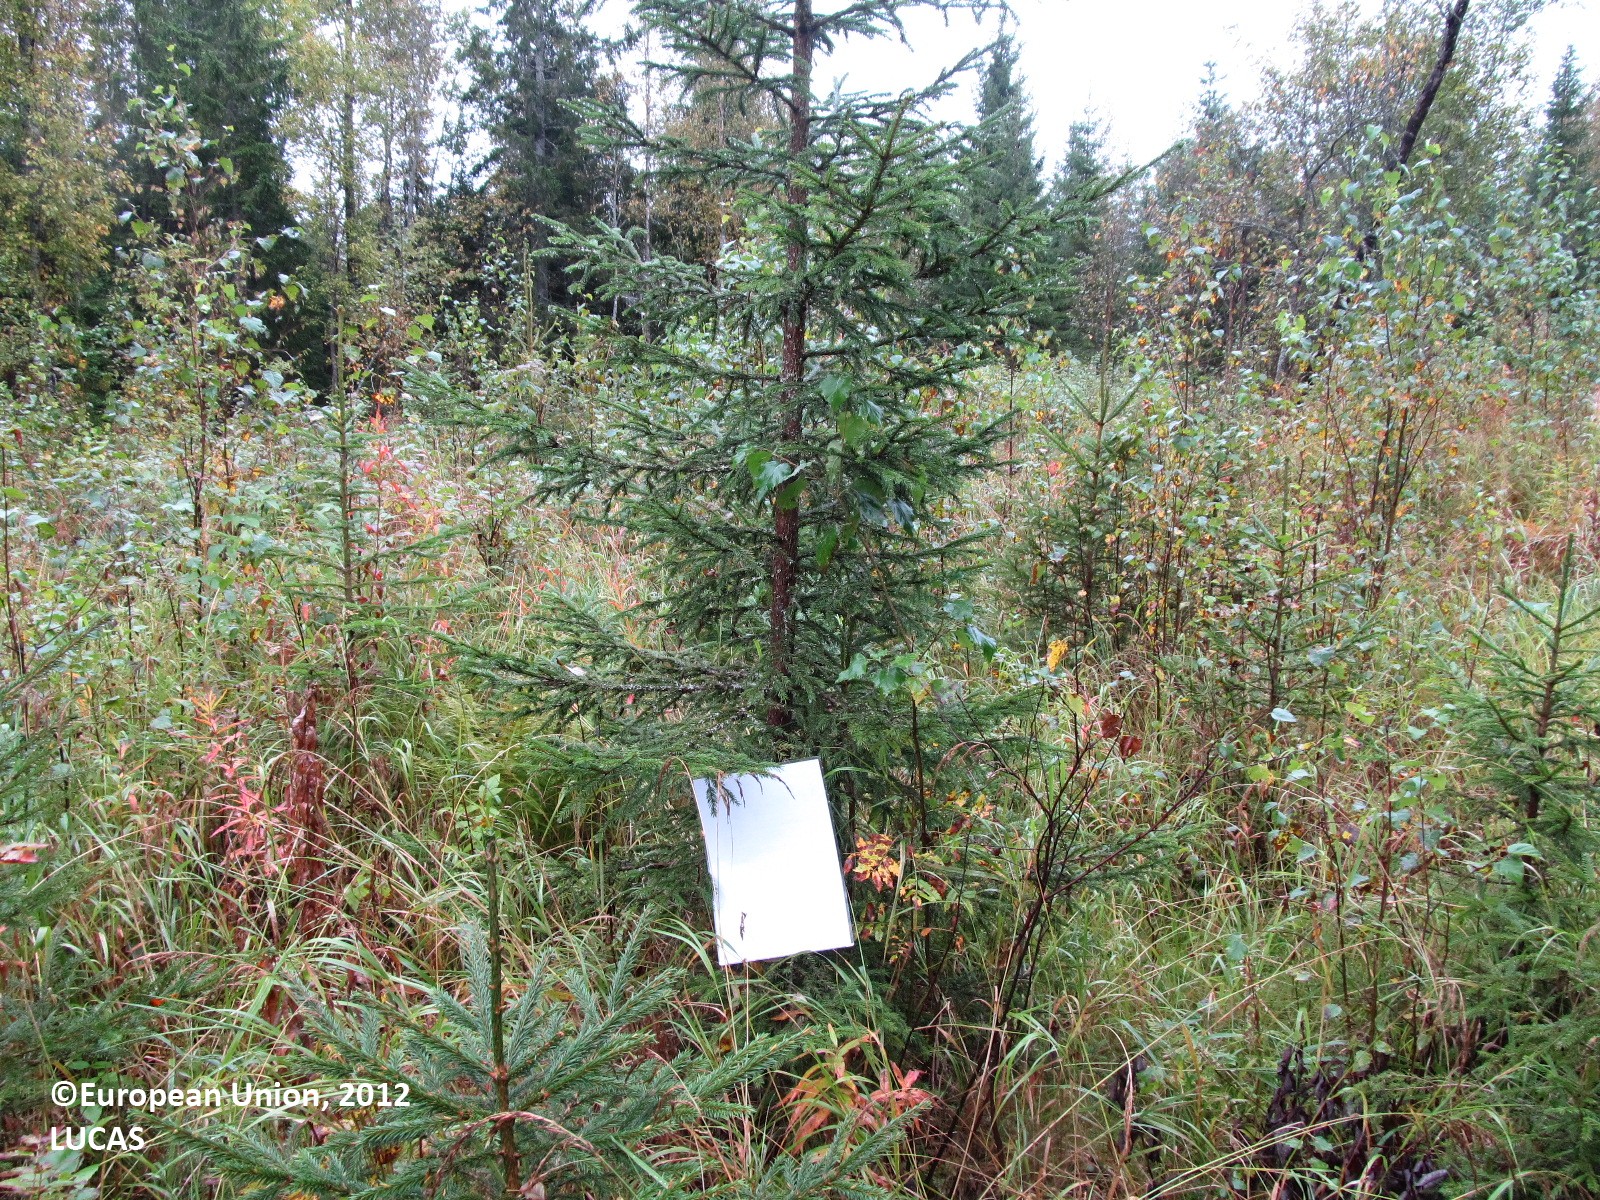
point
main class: Woodland
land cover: Spruce dominated mixed woodland
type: boreal forest
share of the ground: 25 - 50 %
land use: Forestry
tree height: < 5 m
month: September
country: FI
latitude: 63.2746
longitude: 27.8897
